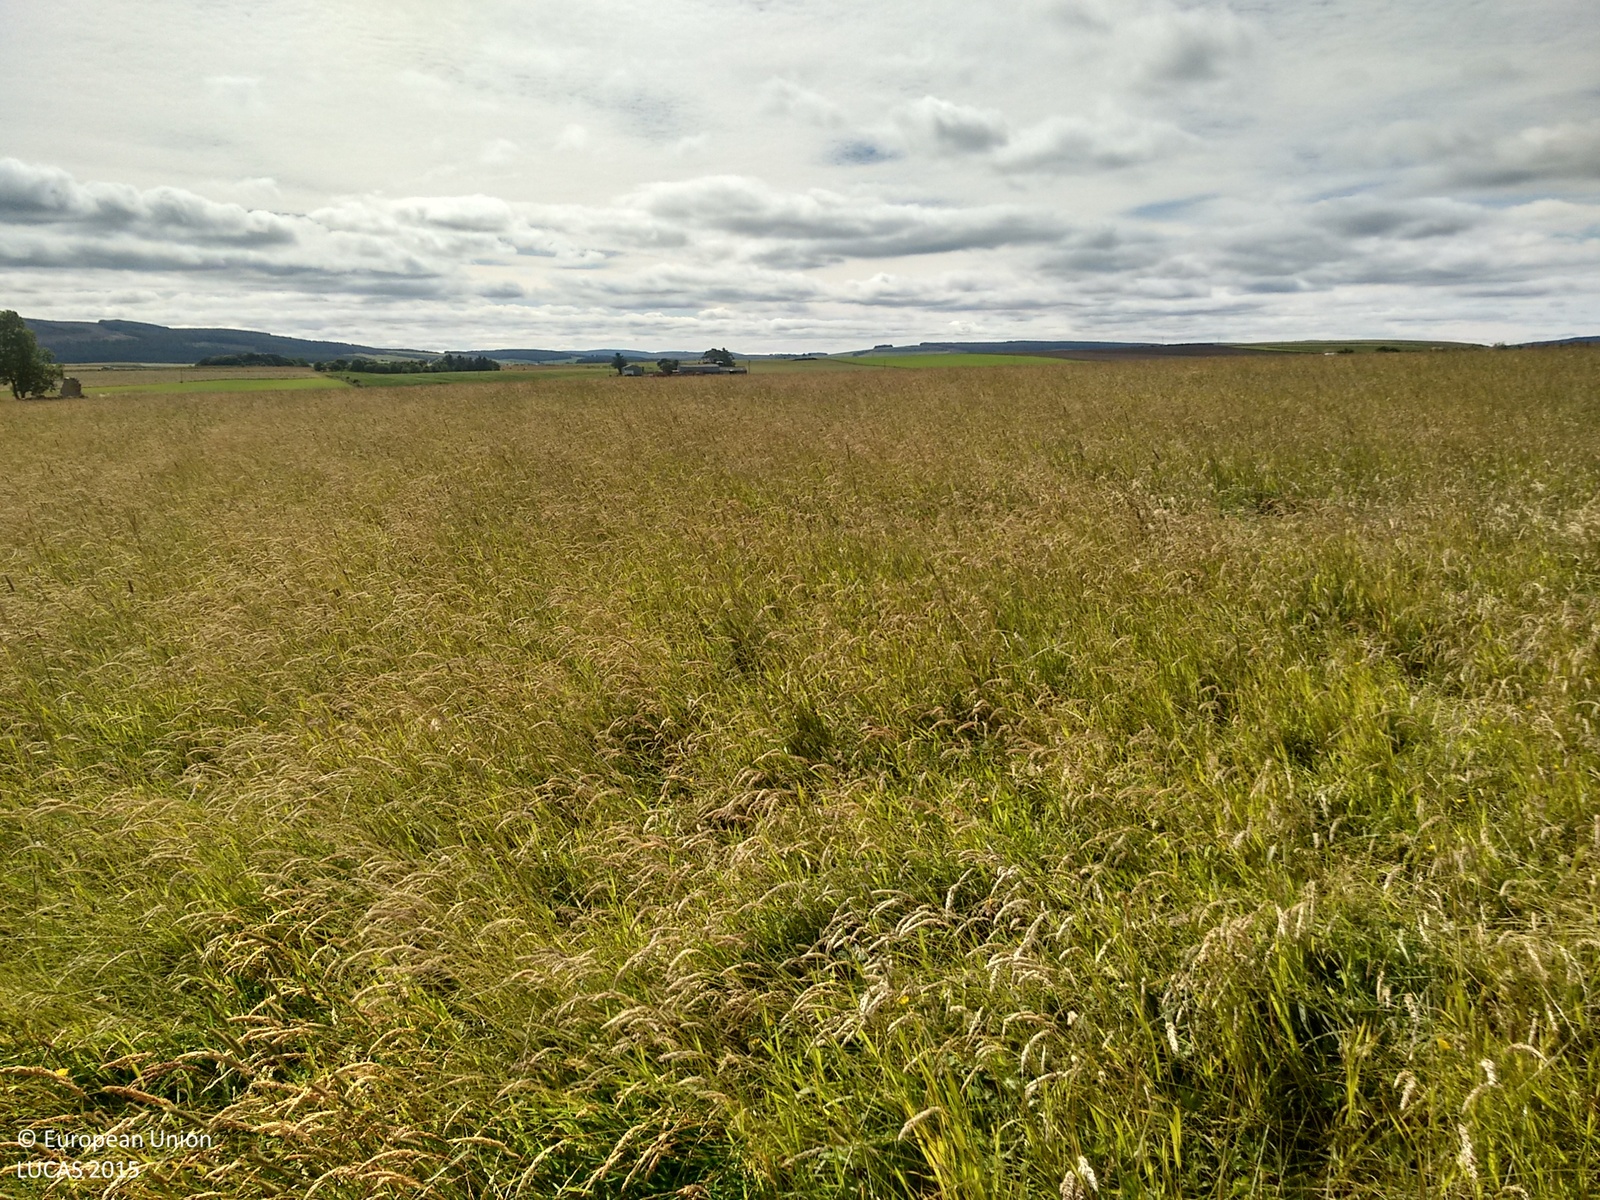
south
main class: Grassland
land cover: Grassland without tree/shrub cover
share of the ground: > 75 %
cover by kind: herbaceous plants 100 %
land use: Agriculture (excluding fallow land and kitchen gardens)
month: August
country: GB
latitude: 57.5744
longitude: -2.9180
